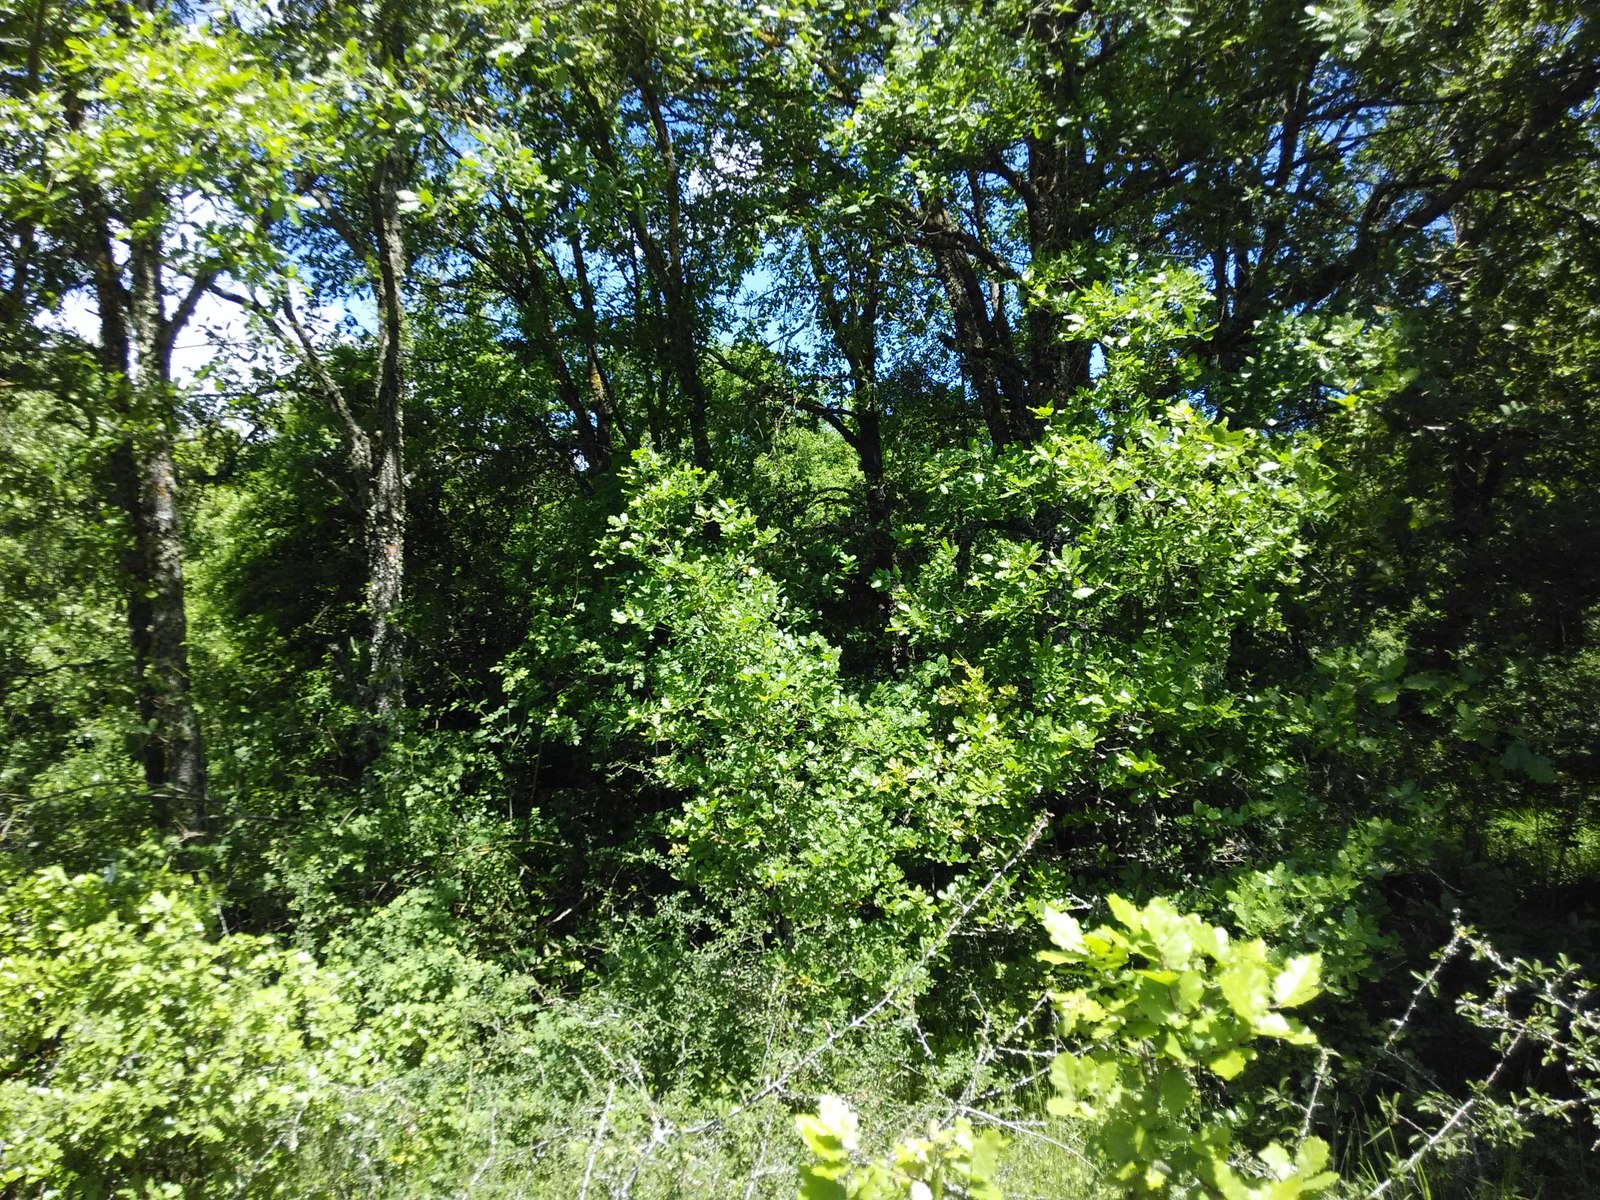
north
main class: Shrubland
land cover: Shrubland with sparse tree cover
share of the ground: > 75 %
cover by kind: shrubs 65 %, herbaceous plants 30 %, broadleaved forest trees 5 %
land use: Forestry
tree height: > 5 m
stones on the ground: < 10 %
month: May
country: ES
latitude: 42.7615
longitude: -2.4258
